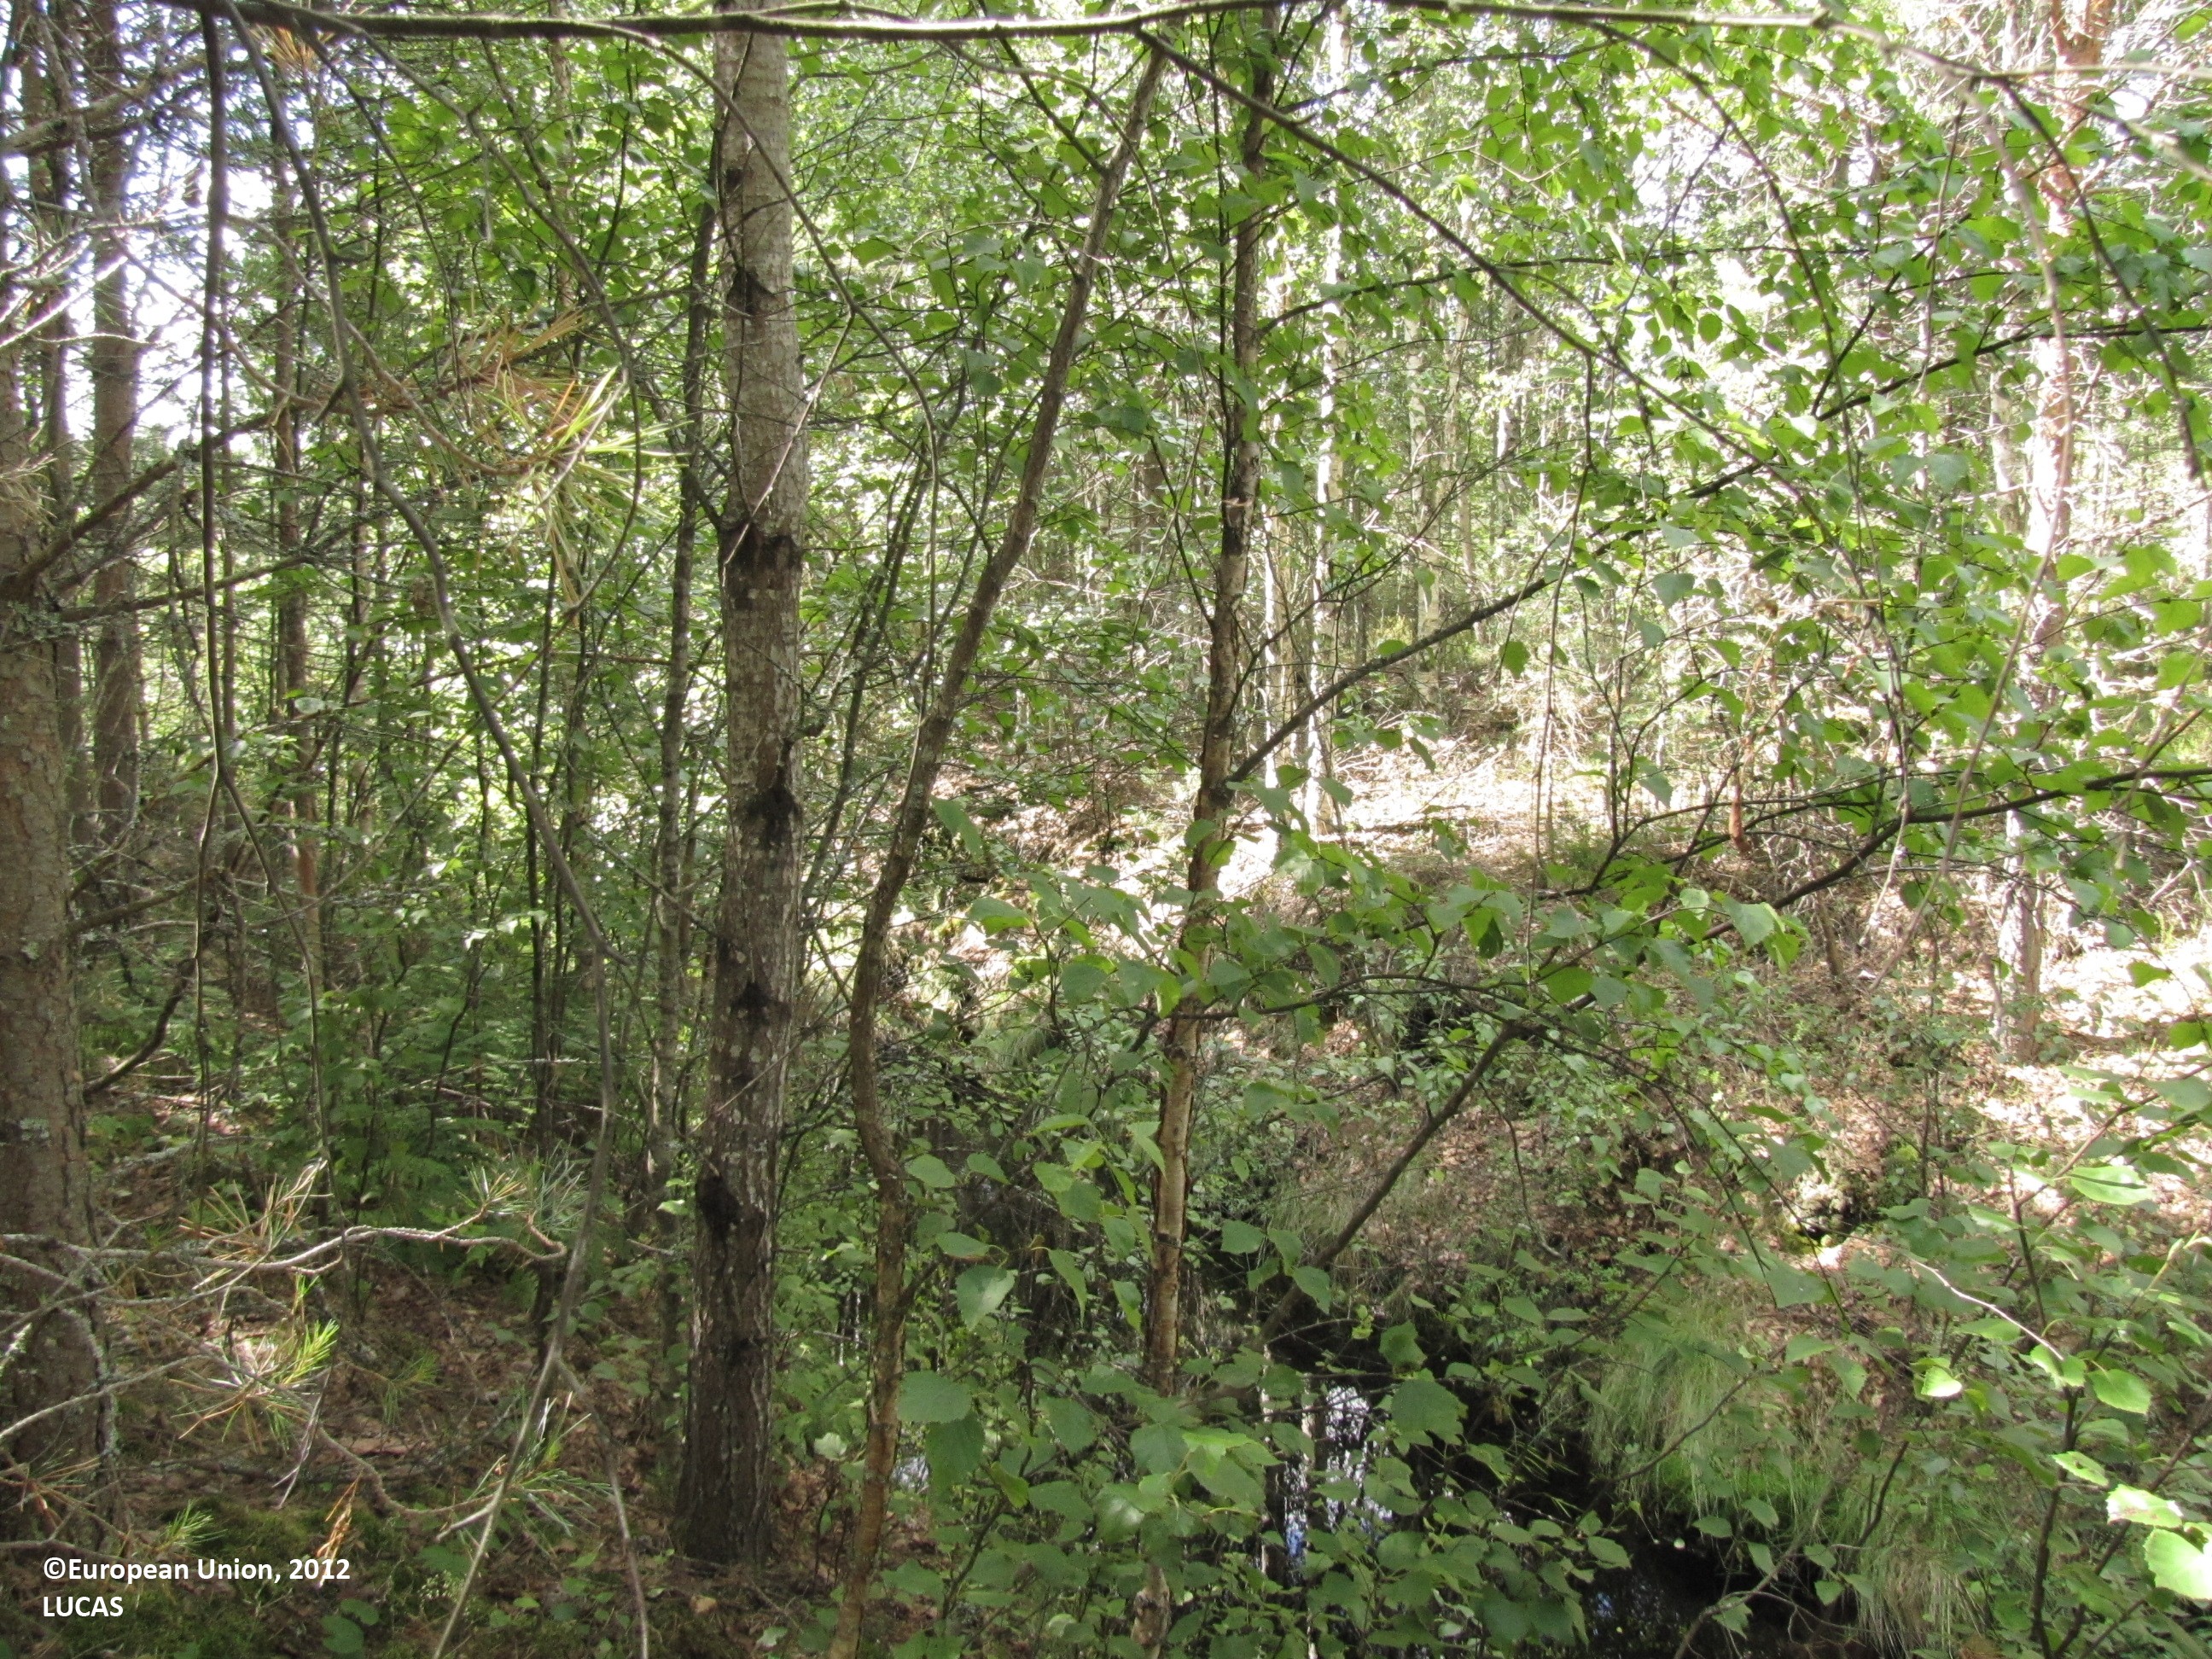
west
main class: Woodland
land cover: Pine dominated coniferous woodland
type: mire and swamp forests
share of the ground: > 75 %
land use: Forestry
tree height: > 5 m
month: July
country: FI
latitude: 62.5288
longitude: 23.3397
